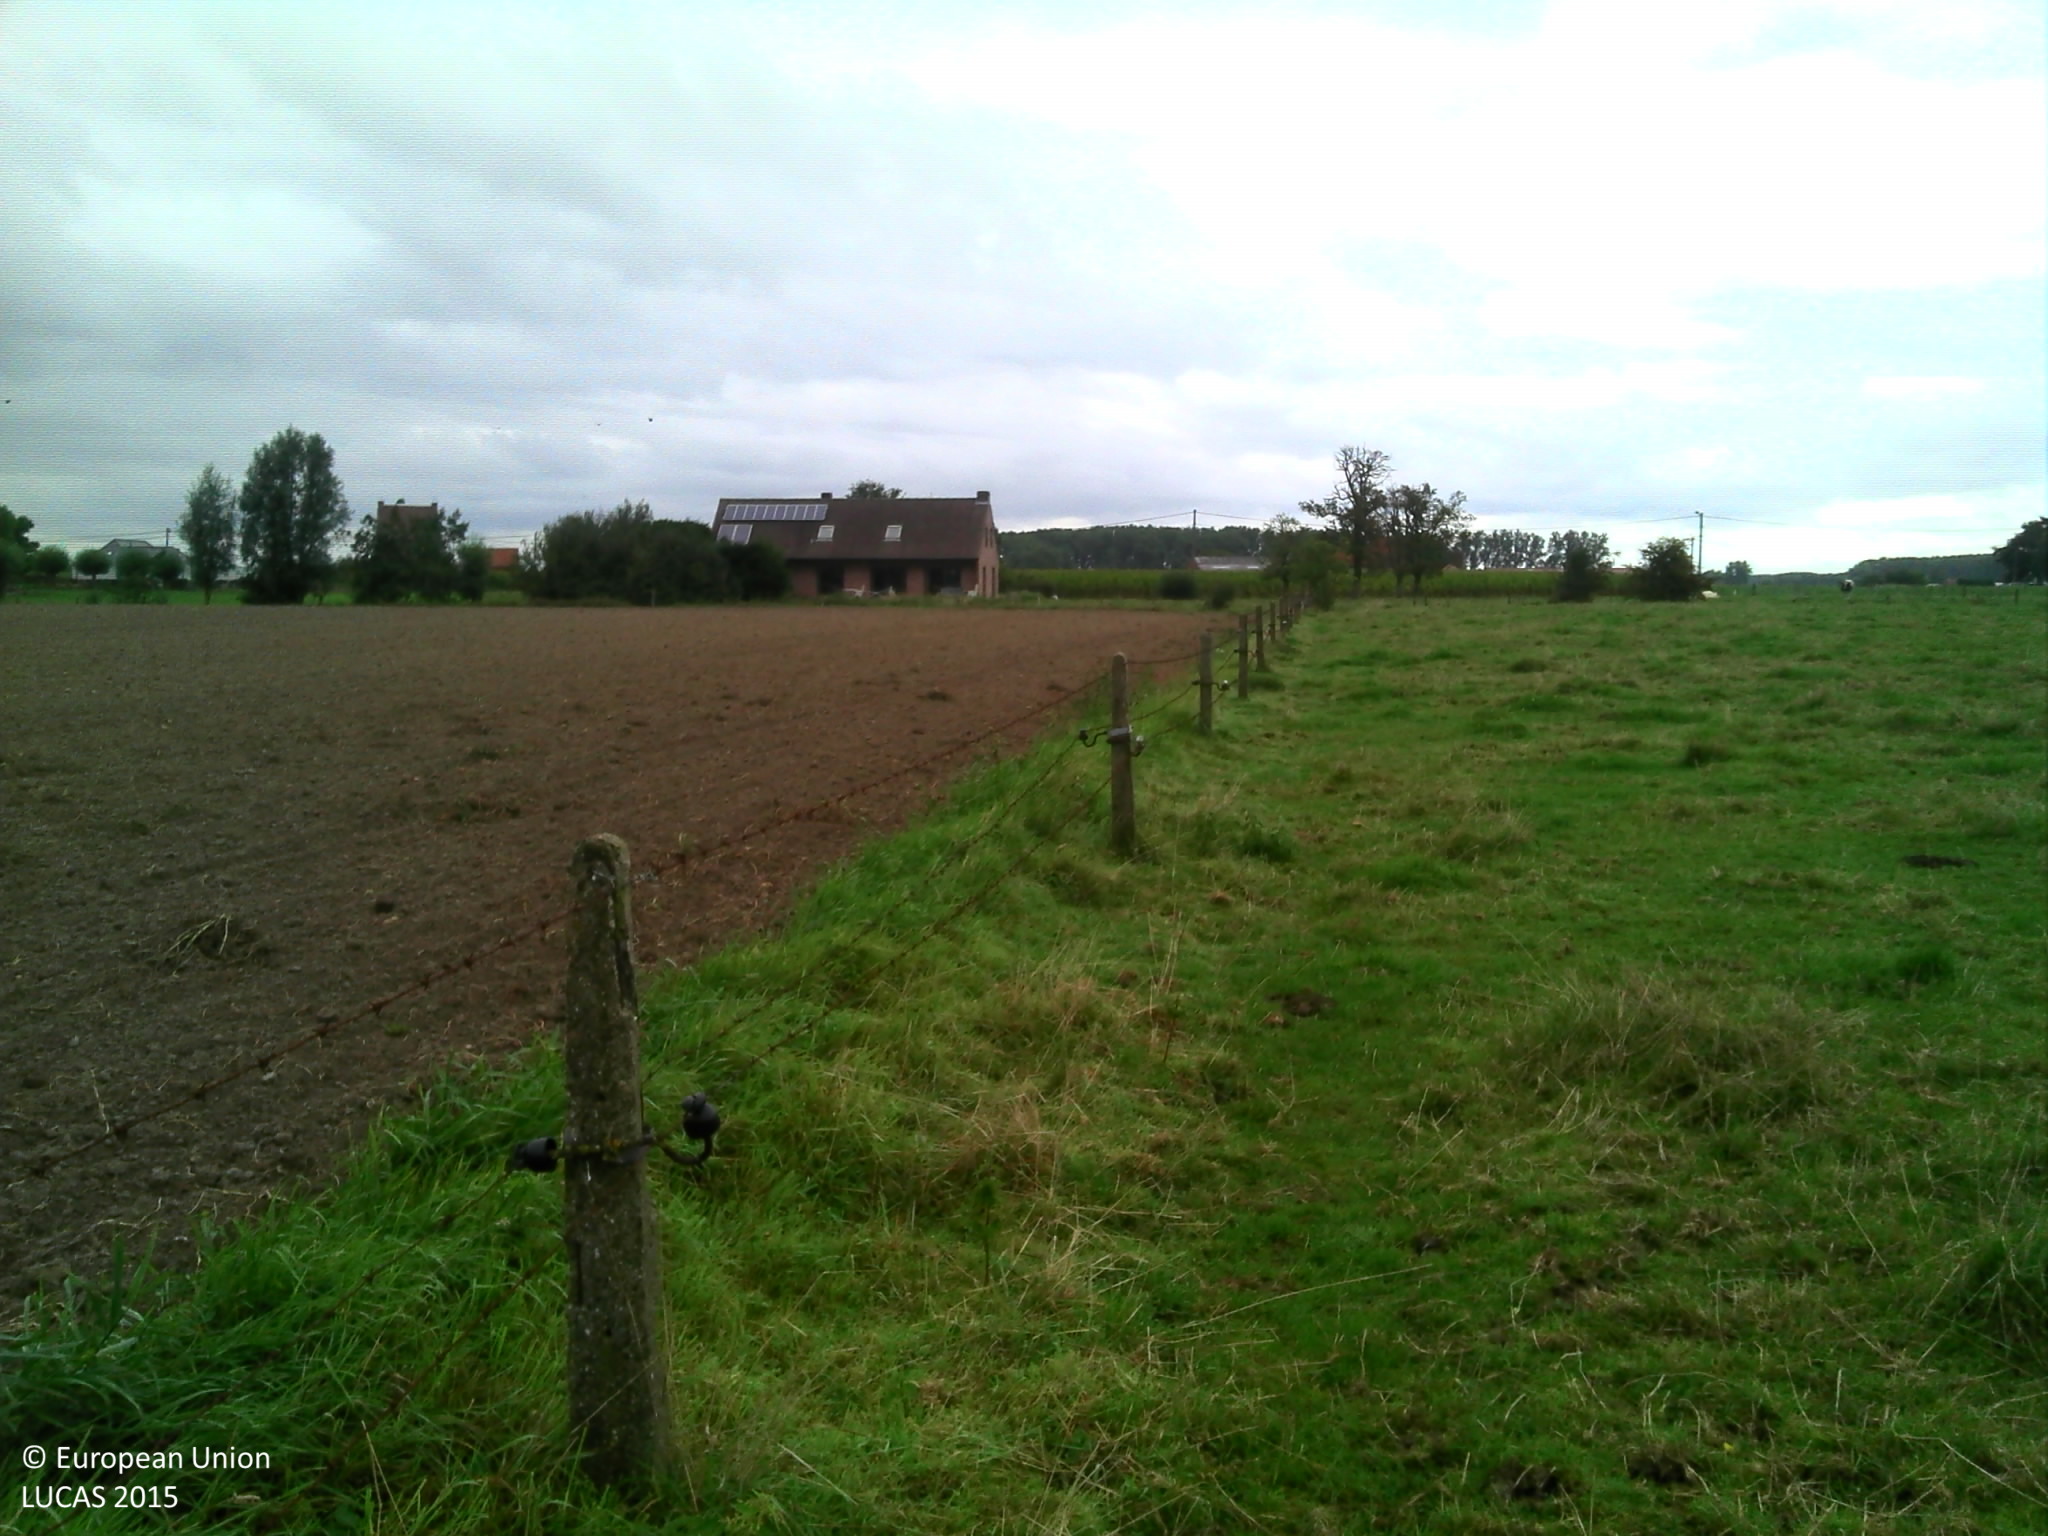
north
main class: Grassland
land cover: Grassland without tree/shrub cover
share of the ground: > 75 %
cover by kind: herbaceous plants 100 %
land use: Agriculture (excluding fallow land and kitchen gardens)
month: September
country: BE
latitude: 51.0403
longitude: 3.4170
